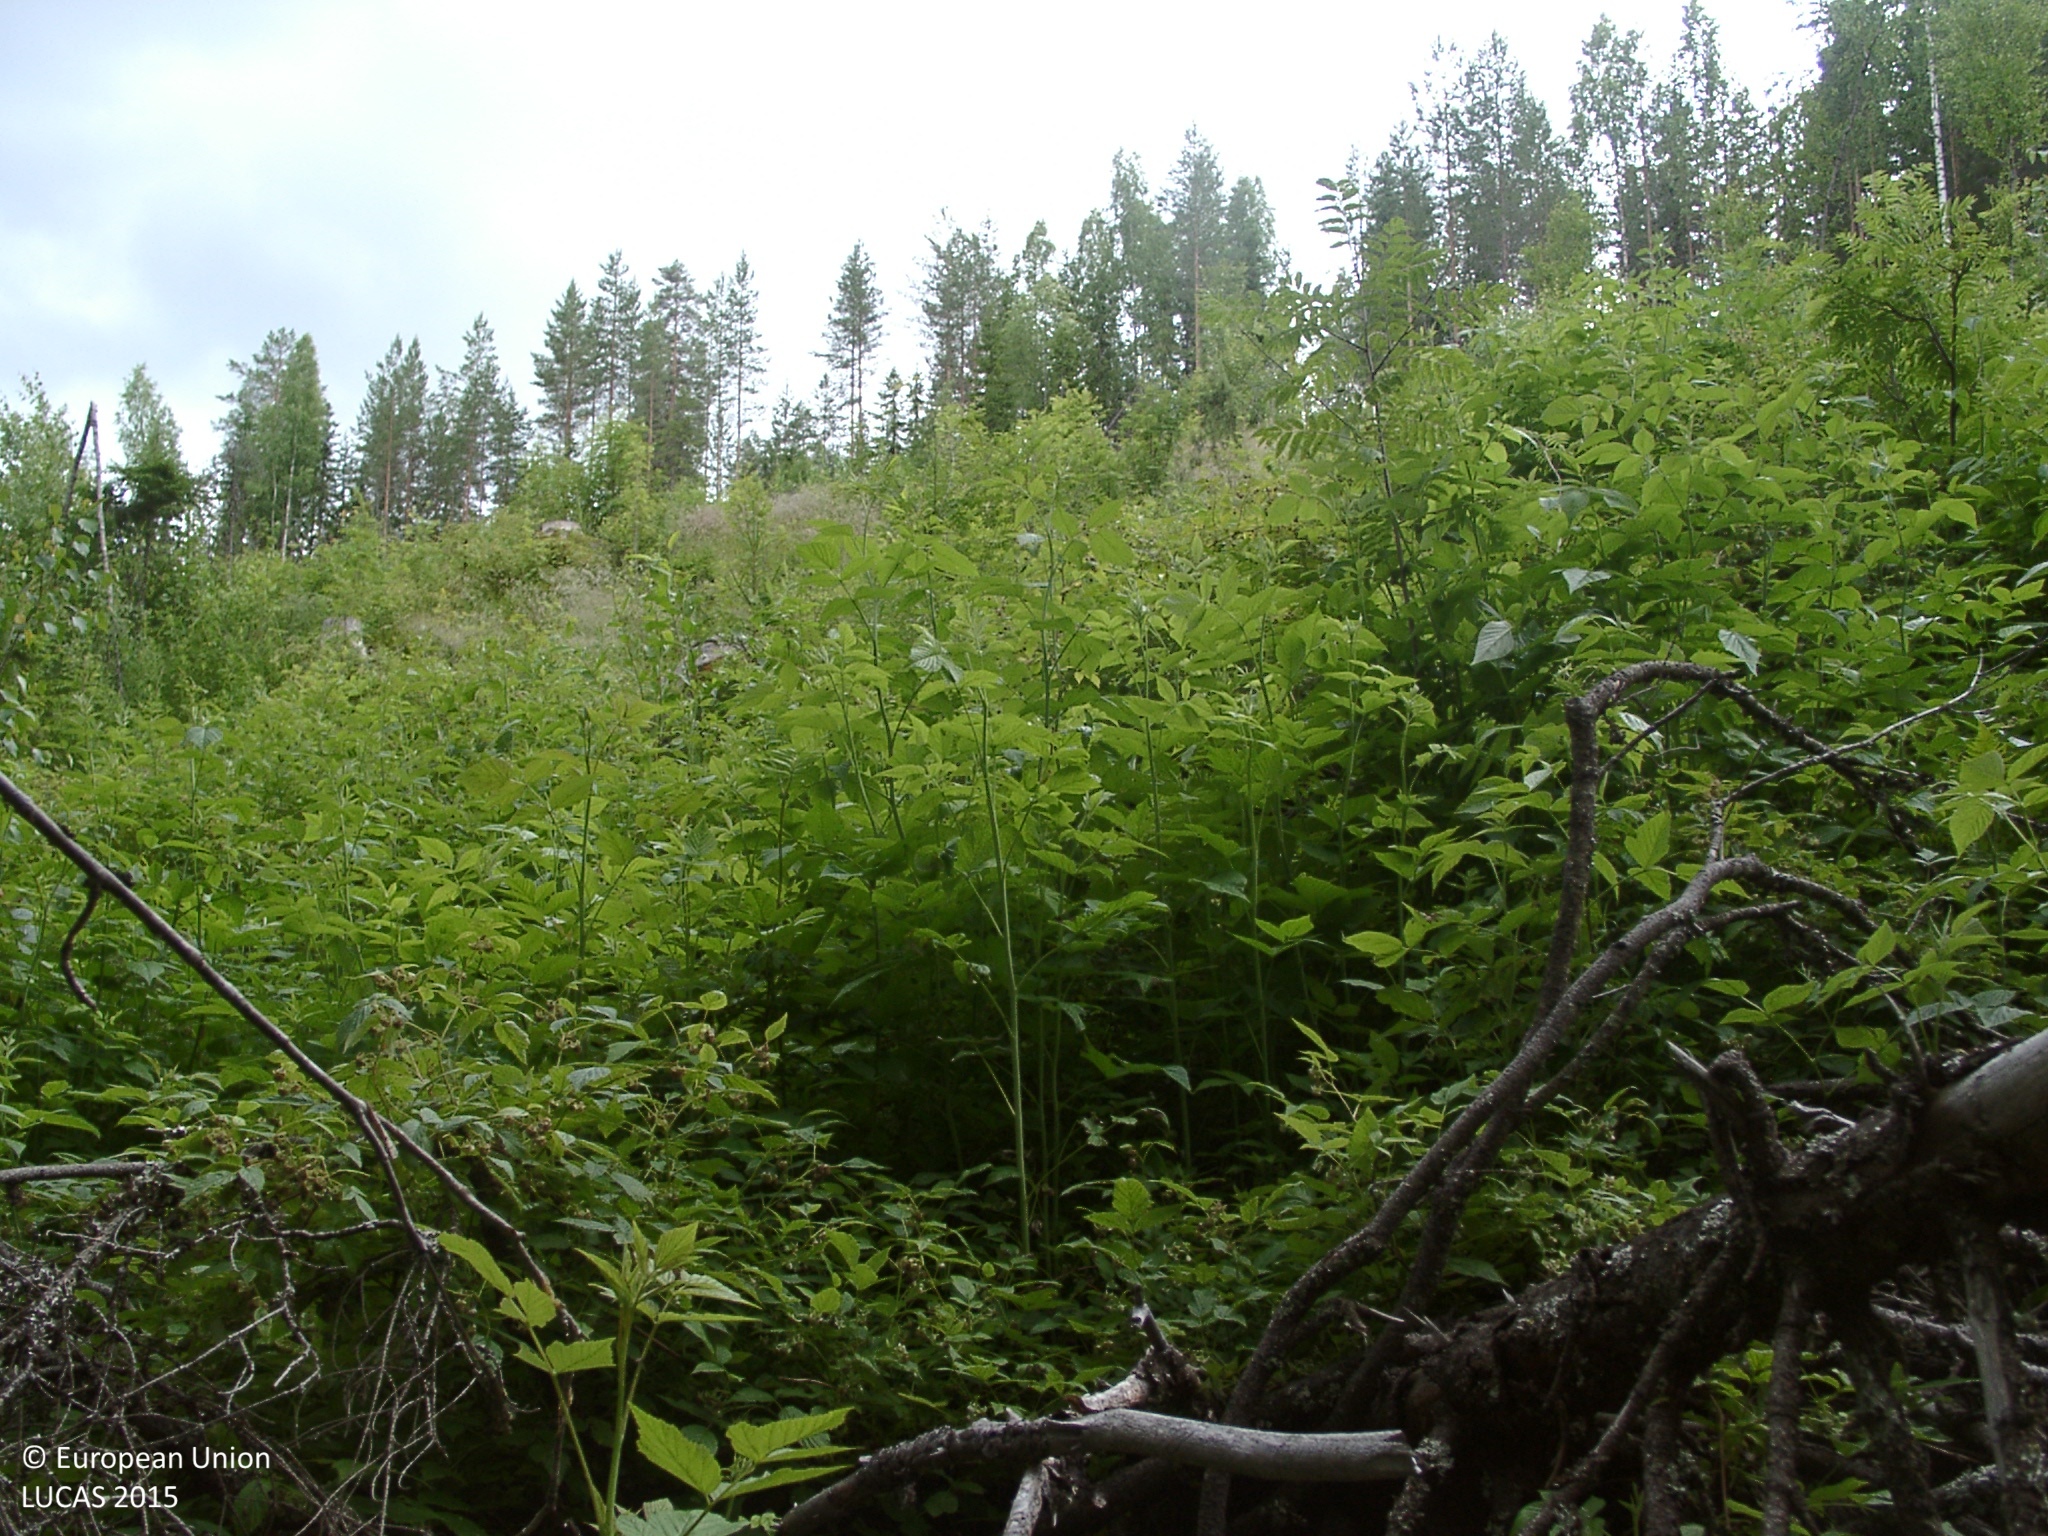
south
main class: Woodland
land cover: Spruce dominated mixed woodland
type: boreal forest
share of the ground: > 75 %
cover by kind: coniferous forest trees 40 %, broadleaved forest trees 35 %, shrubs 15 %, herbaceous plants 10 %
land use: Forestry
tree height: > 5 m
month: July
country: FI
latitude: 61.6501
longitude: 25.1959
